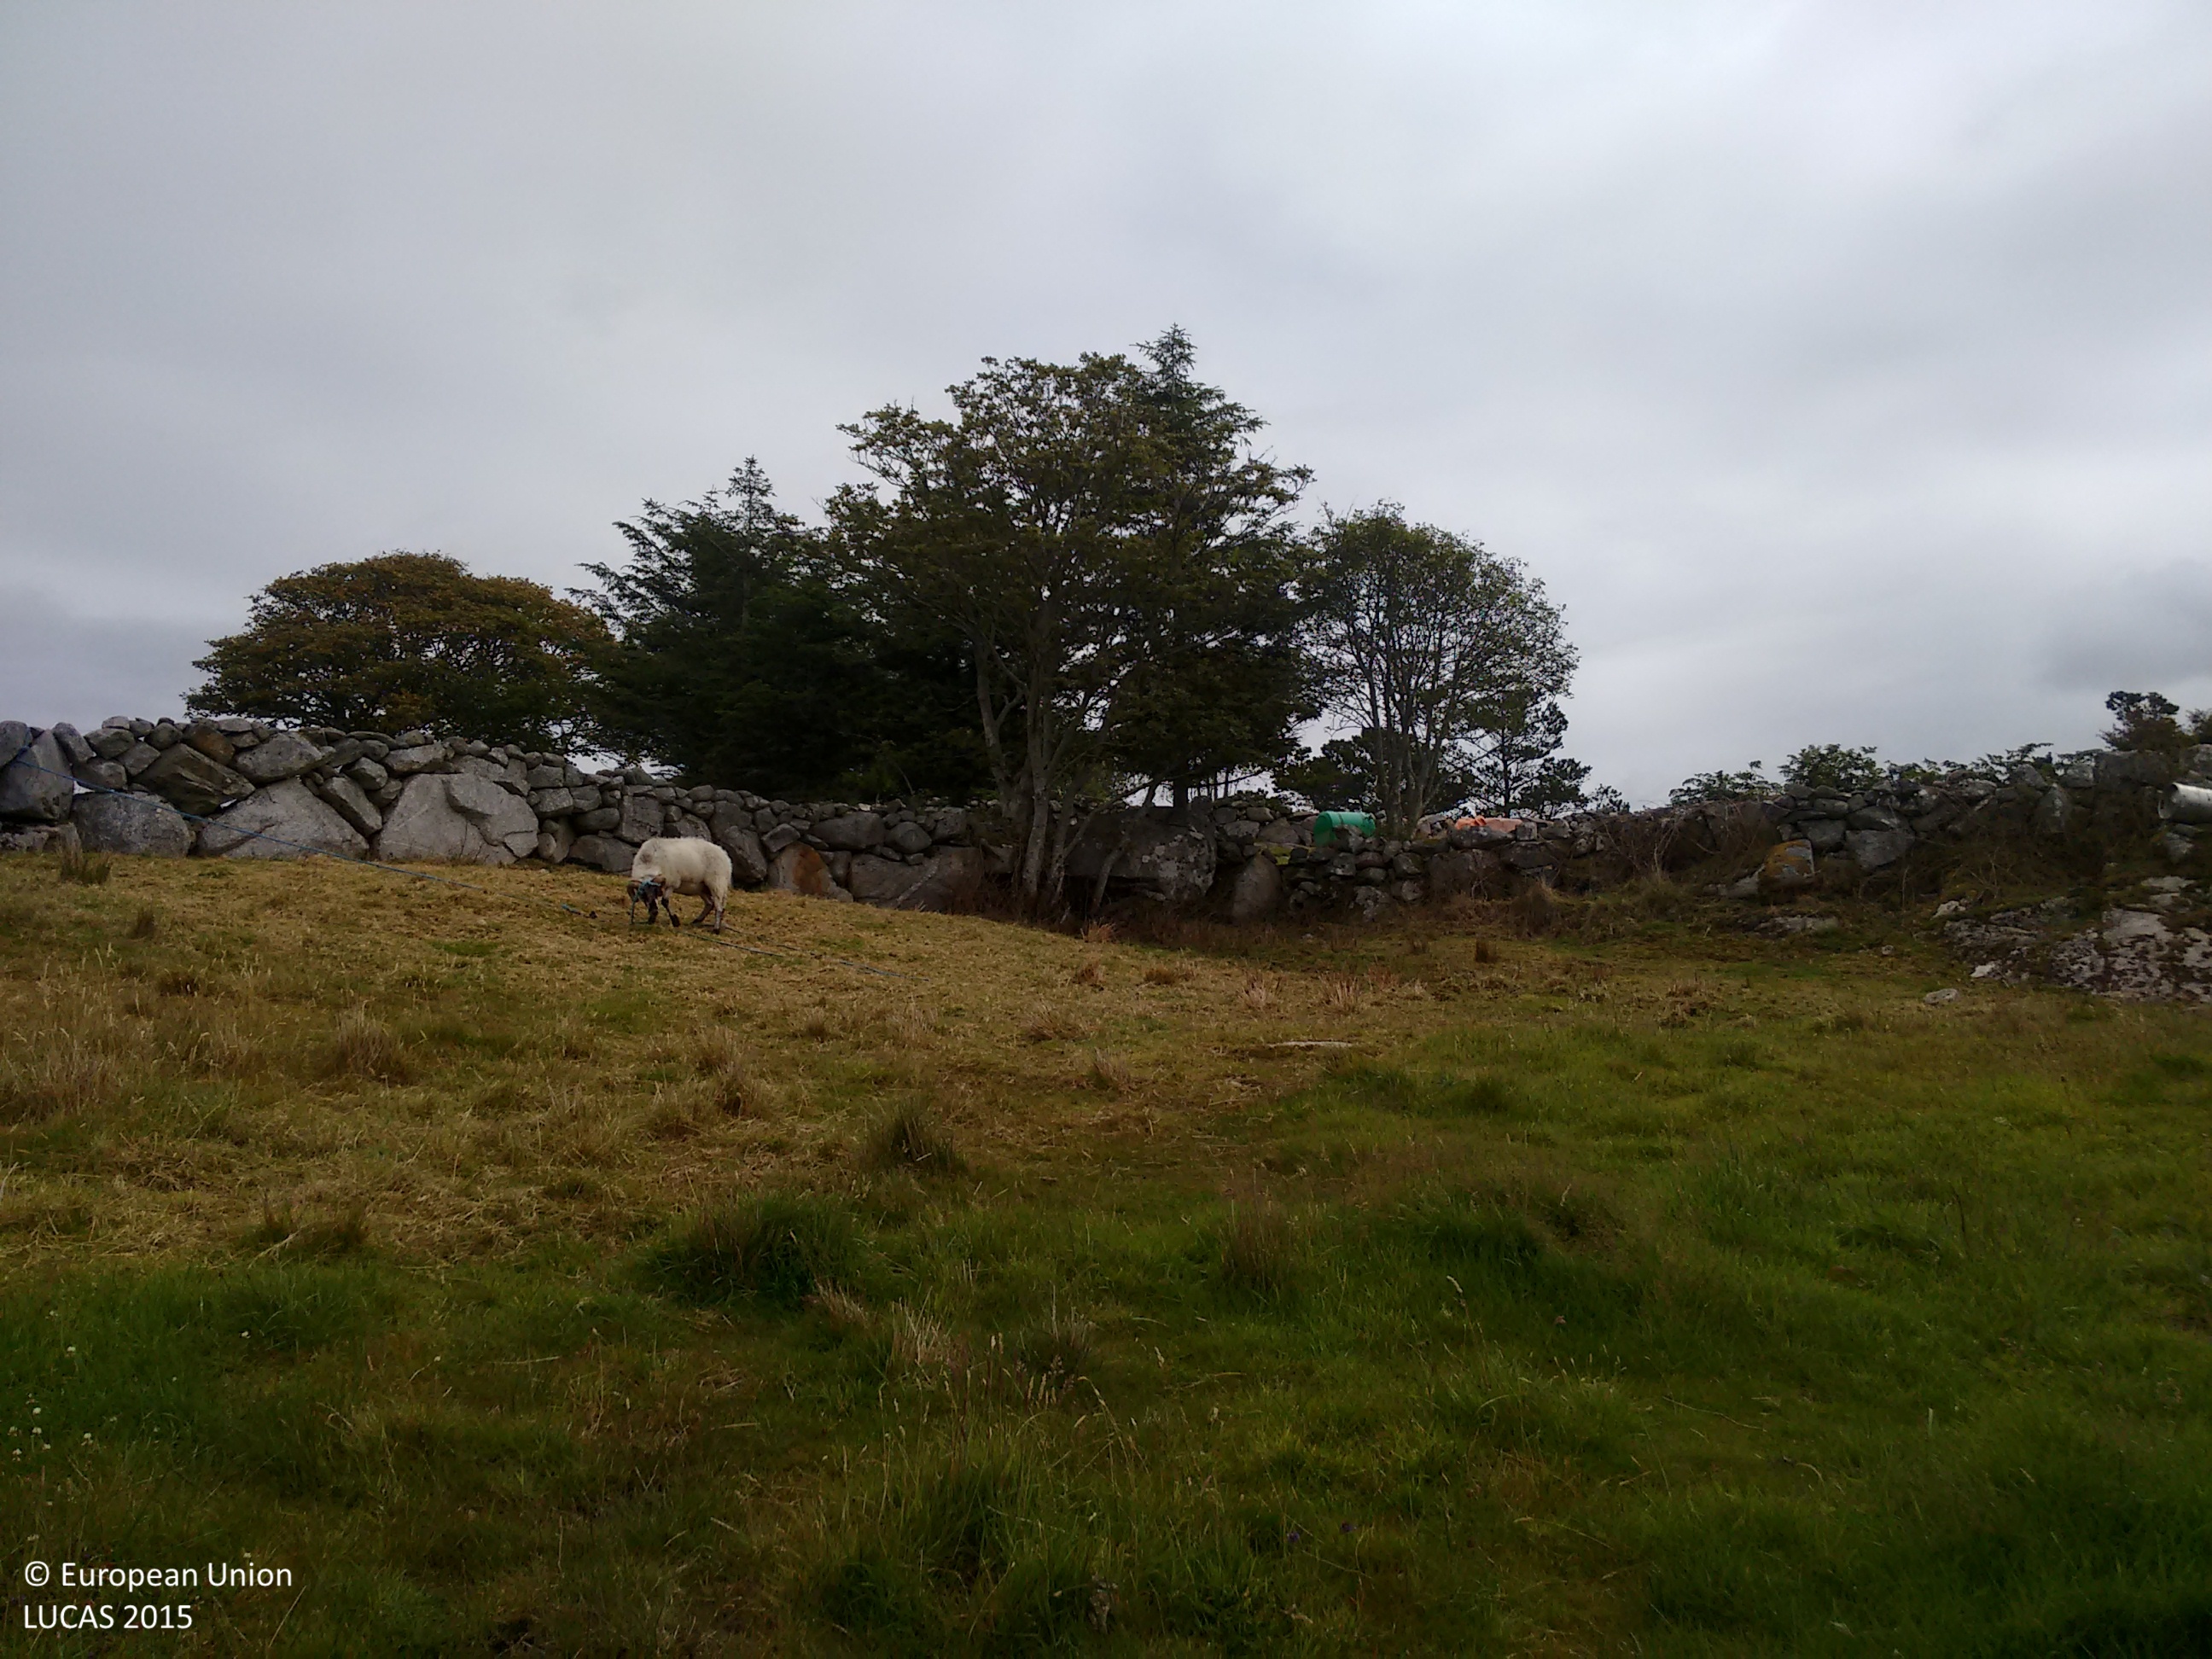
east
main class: Grassland
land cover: Grassland with sparse tree/shrub cover
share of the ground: 50 - 75 %
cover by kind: herbaceous plants 85 %, shrubs 10 %, broadleaved forest trees 5 %
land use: Agriculture (excluding fallow land and kitchen gardens)
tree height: < 5 m
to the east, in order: Grassland with sparse tree/shrub cover; Dry stone walls; Artificial constructions in urban areas; Dry stone walls; Grassland without tree/shrub cover; Dry stone walls; Pine dominated coniferous woodland; Shrubland without tree cover; Electric lines; Shrubland without tree cover; Ponds and wetlands; Rocks and stones; Shrubland without tree cover
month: July
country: IE
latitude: 53.2879
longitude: -9.5403
